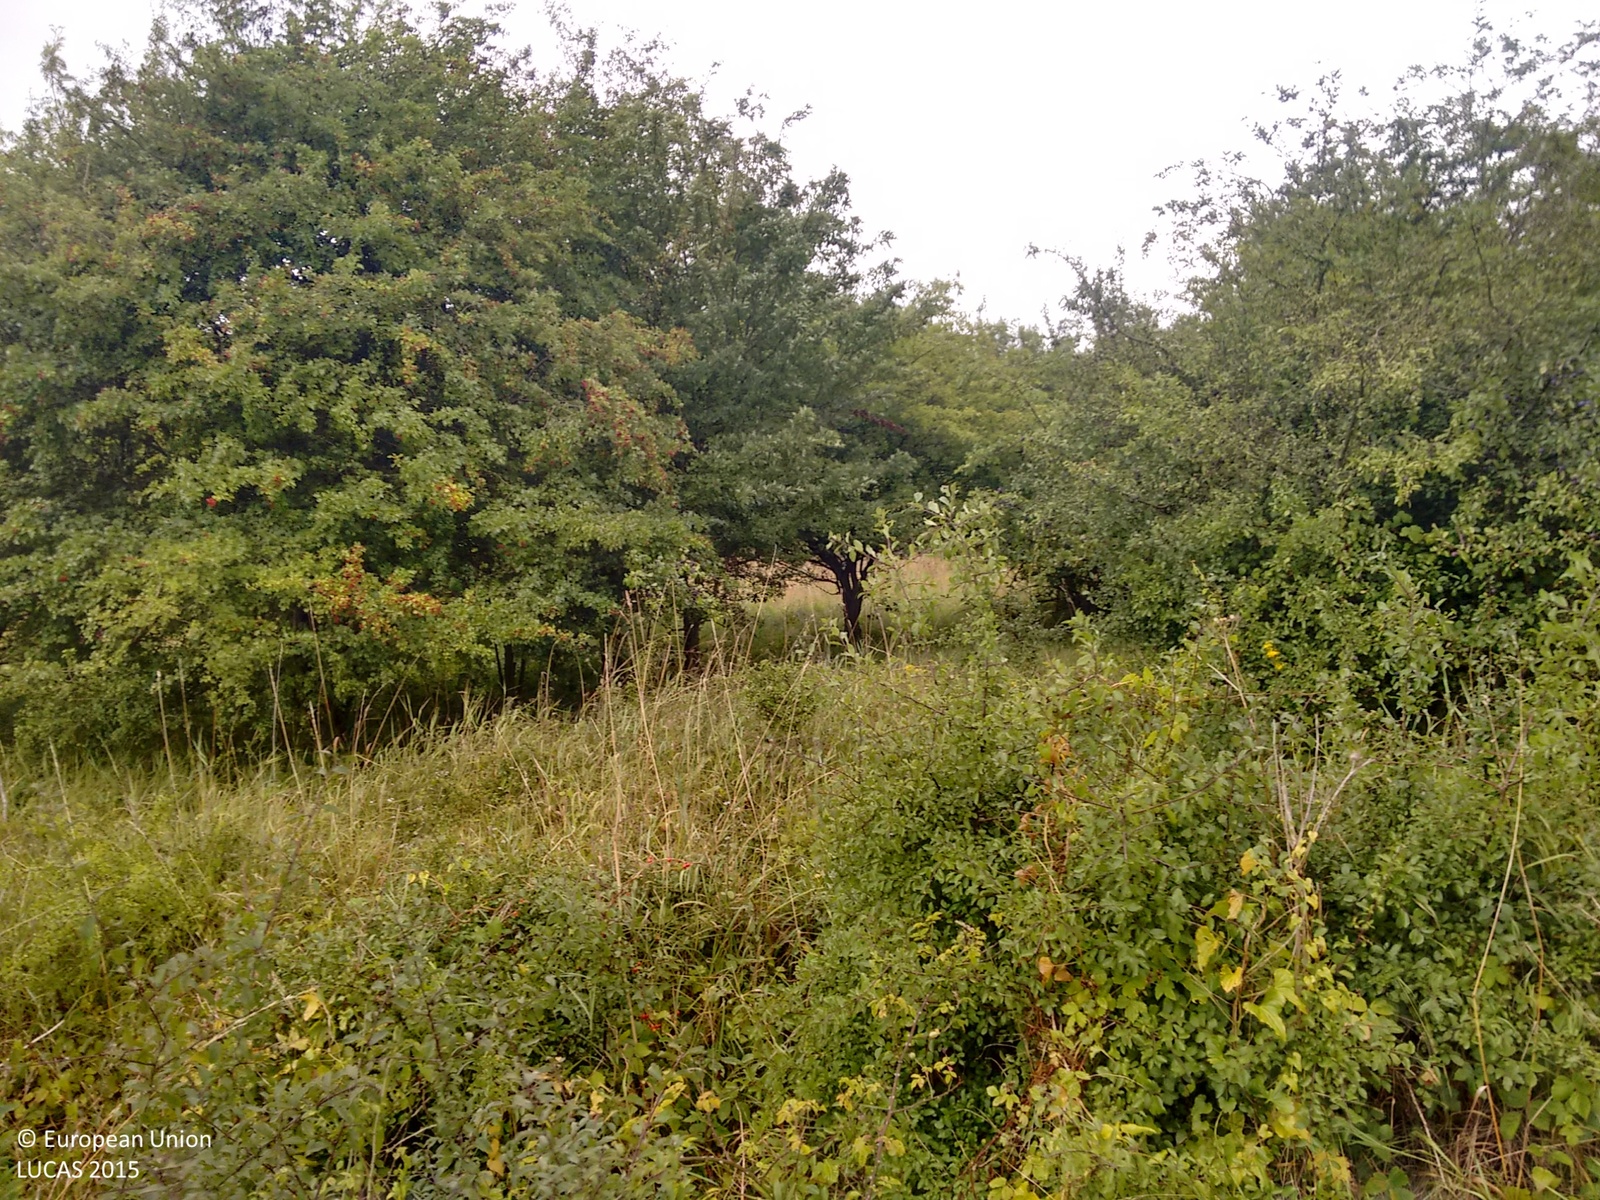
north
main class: Woodland
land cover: Other mixed woodland
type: mesophytic deciduous forest
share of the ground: > 75 %
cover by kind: broadleaved forest trees 70 %, coniferous forest trees 25 %, shrubs 5 %
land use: Semi-natural and natural areas not in use
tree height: > 5 m
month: August
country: GB
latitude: 52.1242
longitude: 0.5222
